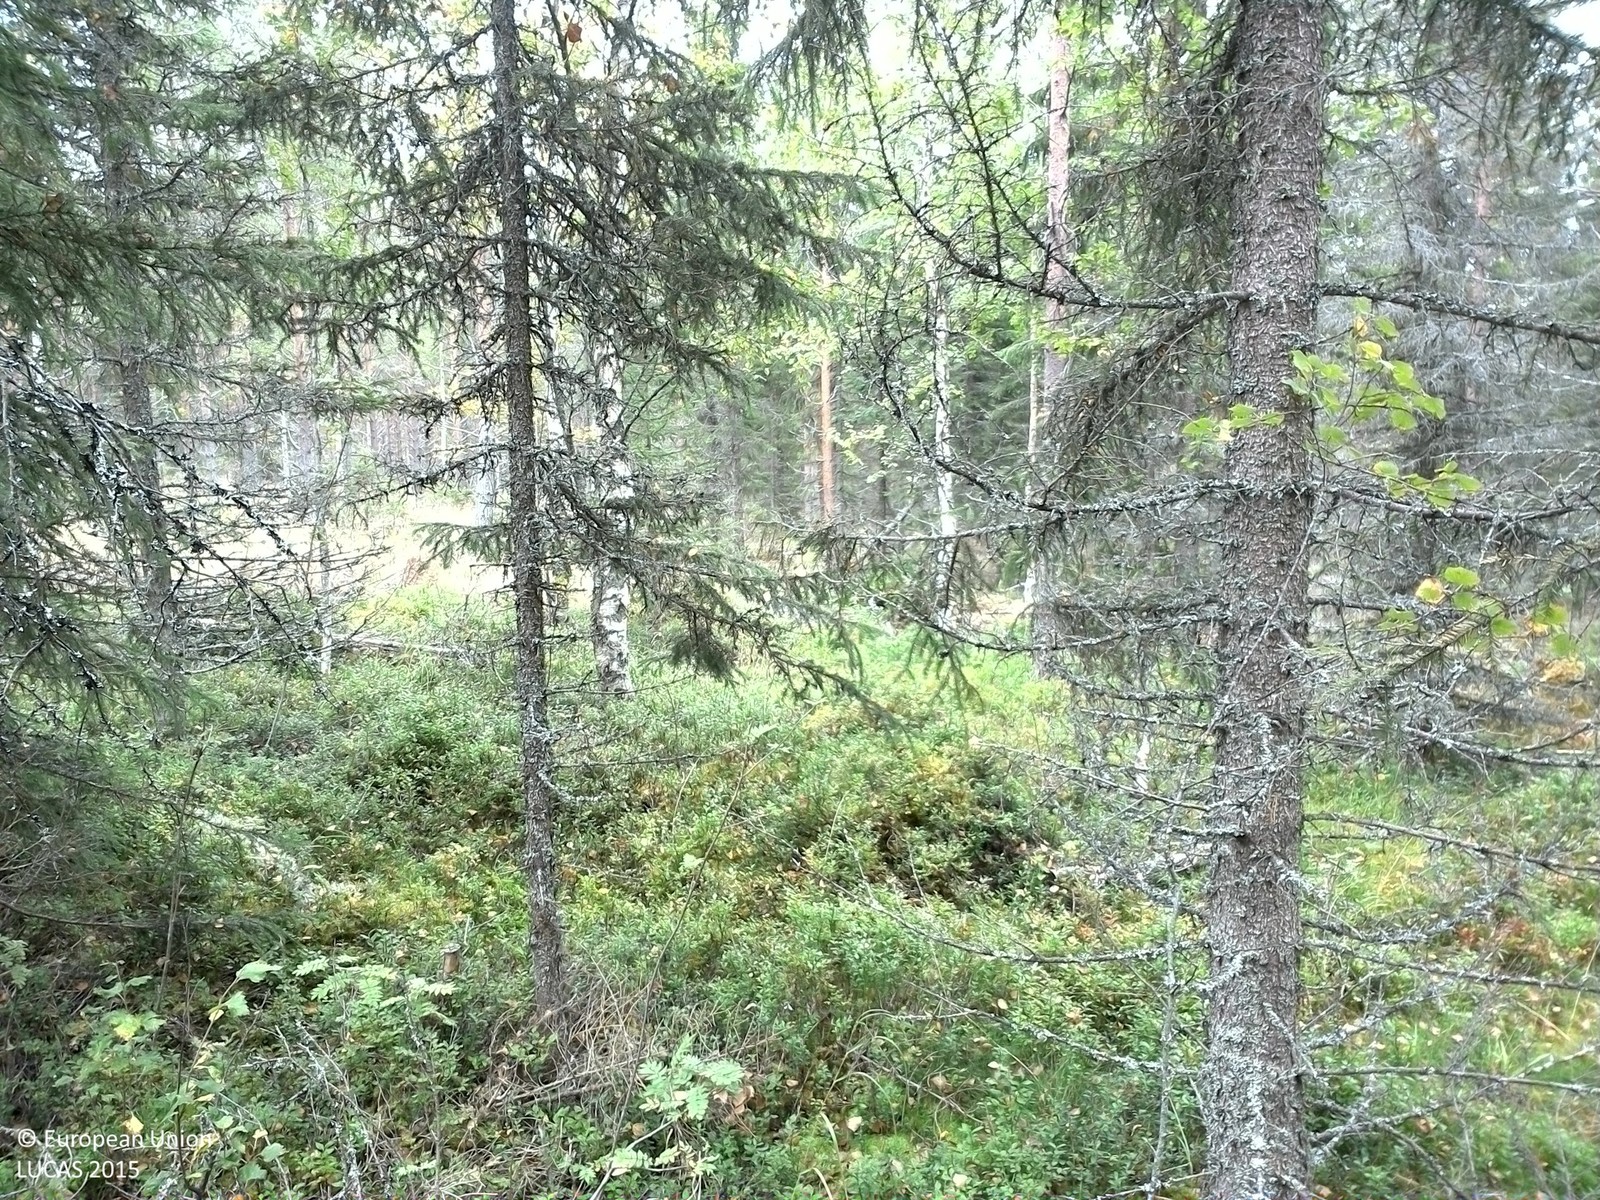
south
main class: Woodland
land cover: Other mixed woodland
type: boreal forest
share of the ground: 50 - 75 %
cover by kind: coniferous forest trees 30 %, broadleaved forest trees 30 %, shrubs 25 %, lichens and mosses 10 %, herbaceous plants 5 %
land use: Forestry
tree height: > 5 m
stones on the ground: 10 - 25 %
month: September
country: SE
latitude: 61.5691
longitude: 15.0865
